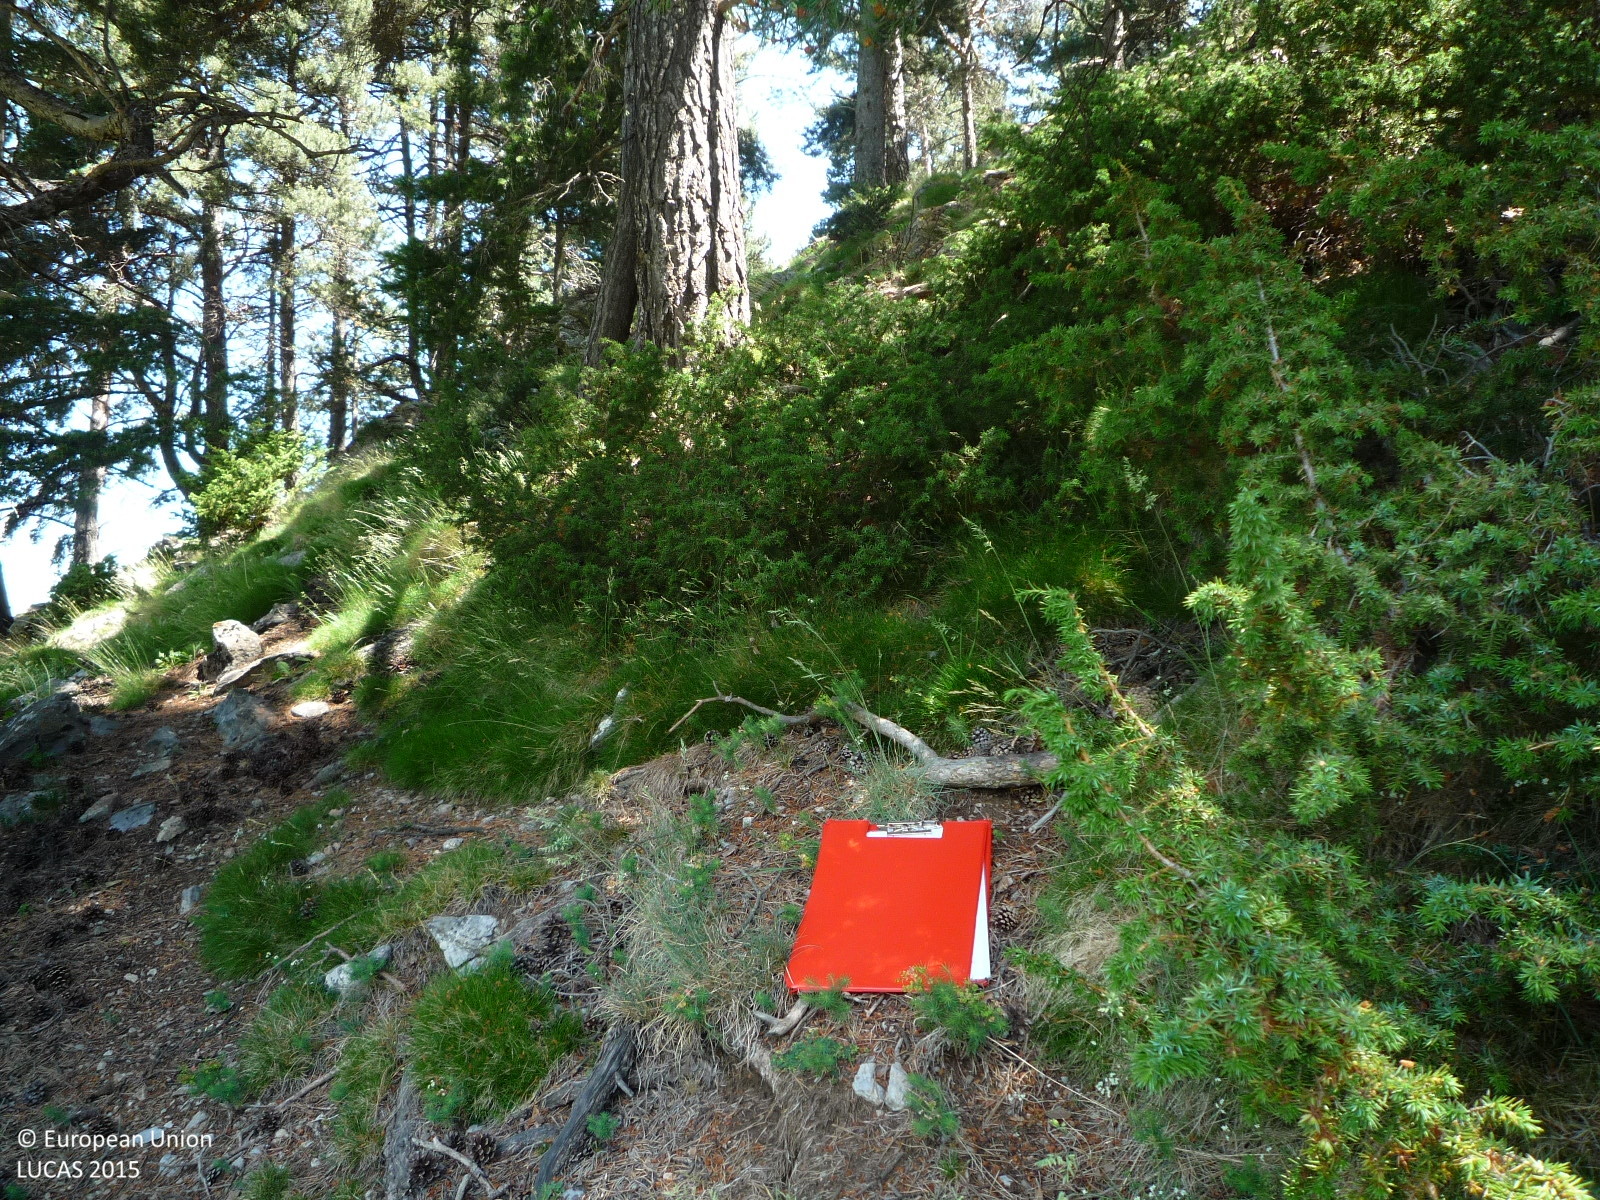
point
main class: Woodland
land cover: Pine dominated coniferous woodland
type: alpine coniferous forest
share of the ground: > 75 %
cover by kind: coniferous forest trees 80 %, shrubs 10 %, herbaceous plants 10 %
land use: Sport
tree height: > 5 m
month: June
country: ES
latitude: 42.3325
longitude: 1.9412
